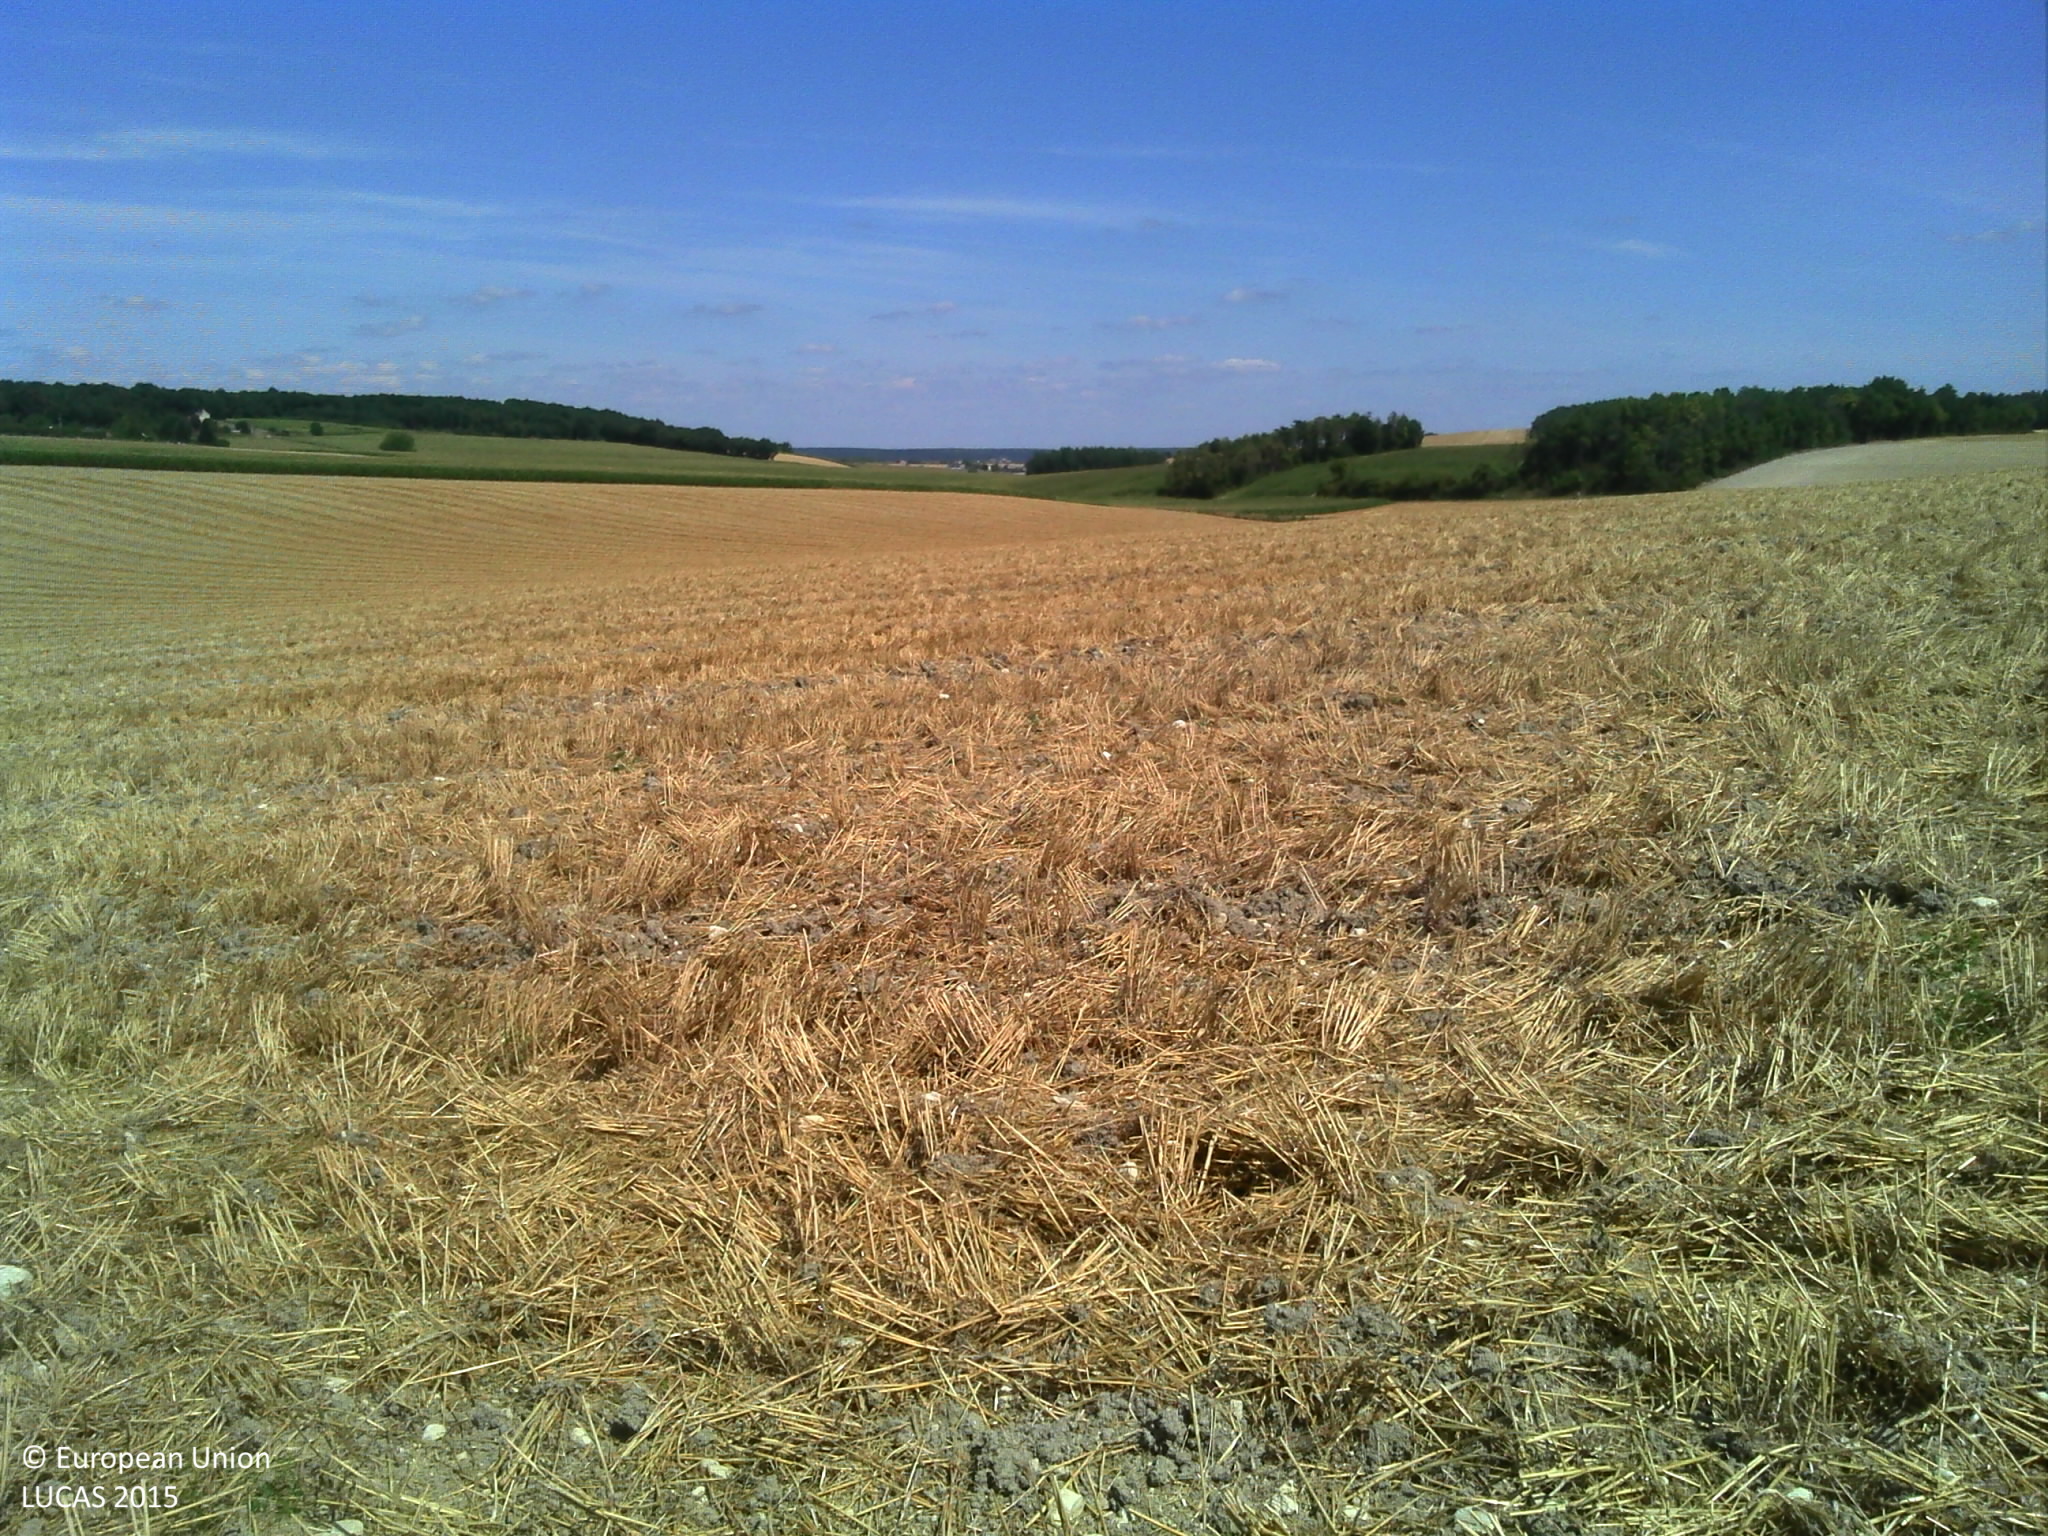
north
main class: Cropland
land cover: Common wheat
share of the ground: > 75 %
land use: Agriculture (excluding fallow land and kitchen gardens)
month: July
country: FR
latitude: 47.0792
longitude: 0.4044
